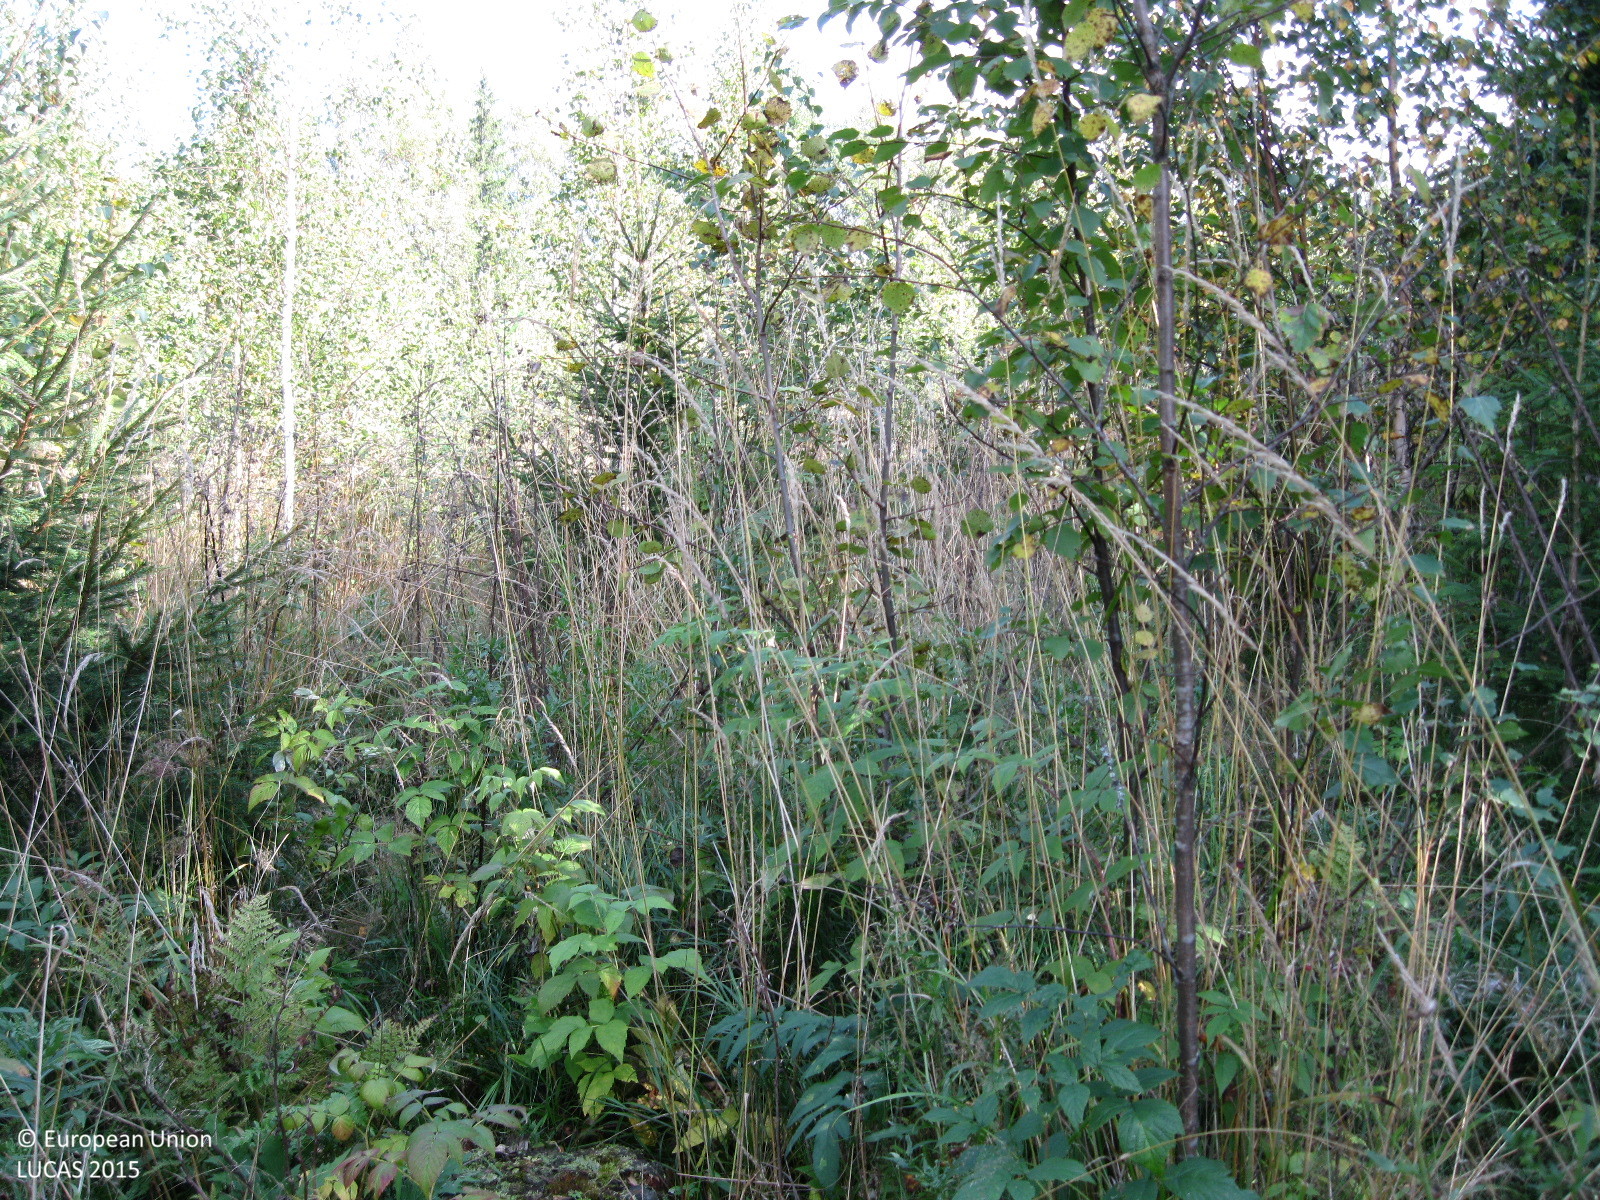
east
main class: Woodland
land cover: Broadleaved woodland
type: boreal forest
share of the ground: > 75 %
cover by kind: broadleaved forest trees 80 %, herbaceous plants 15 %, coniferous forest trees 5 %
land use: Forestry
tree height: > 5 m
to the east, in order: Broadleaved woodland; Ditches and canals; Grassland without tree/shrub cover; Paved roads, cycling and walking lanes; Grassland without tree/shrub cover; Electric lines; Grassland without tree/shrub cover; Shrubland with sparse tree cover; Fences; Spruce dominated mixed woodland; Grassland without tree/shrub cover; Paved roads, cycling and walking lanes; Grassland without tree/shrub cover; Paved roads, cycling and walking lanes; Grass margins; Ditches and canals; Grass margins; Paved roads, cycling and walking lanes; Grassland with sparse tree/shrub cover; Fences; Broadleaved woodland; Spruce dominated mixed woodland
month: September
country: FI
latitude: 60.5092
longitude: 24.8463
